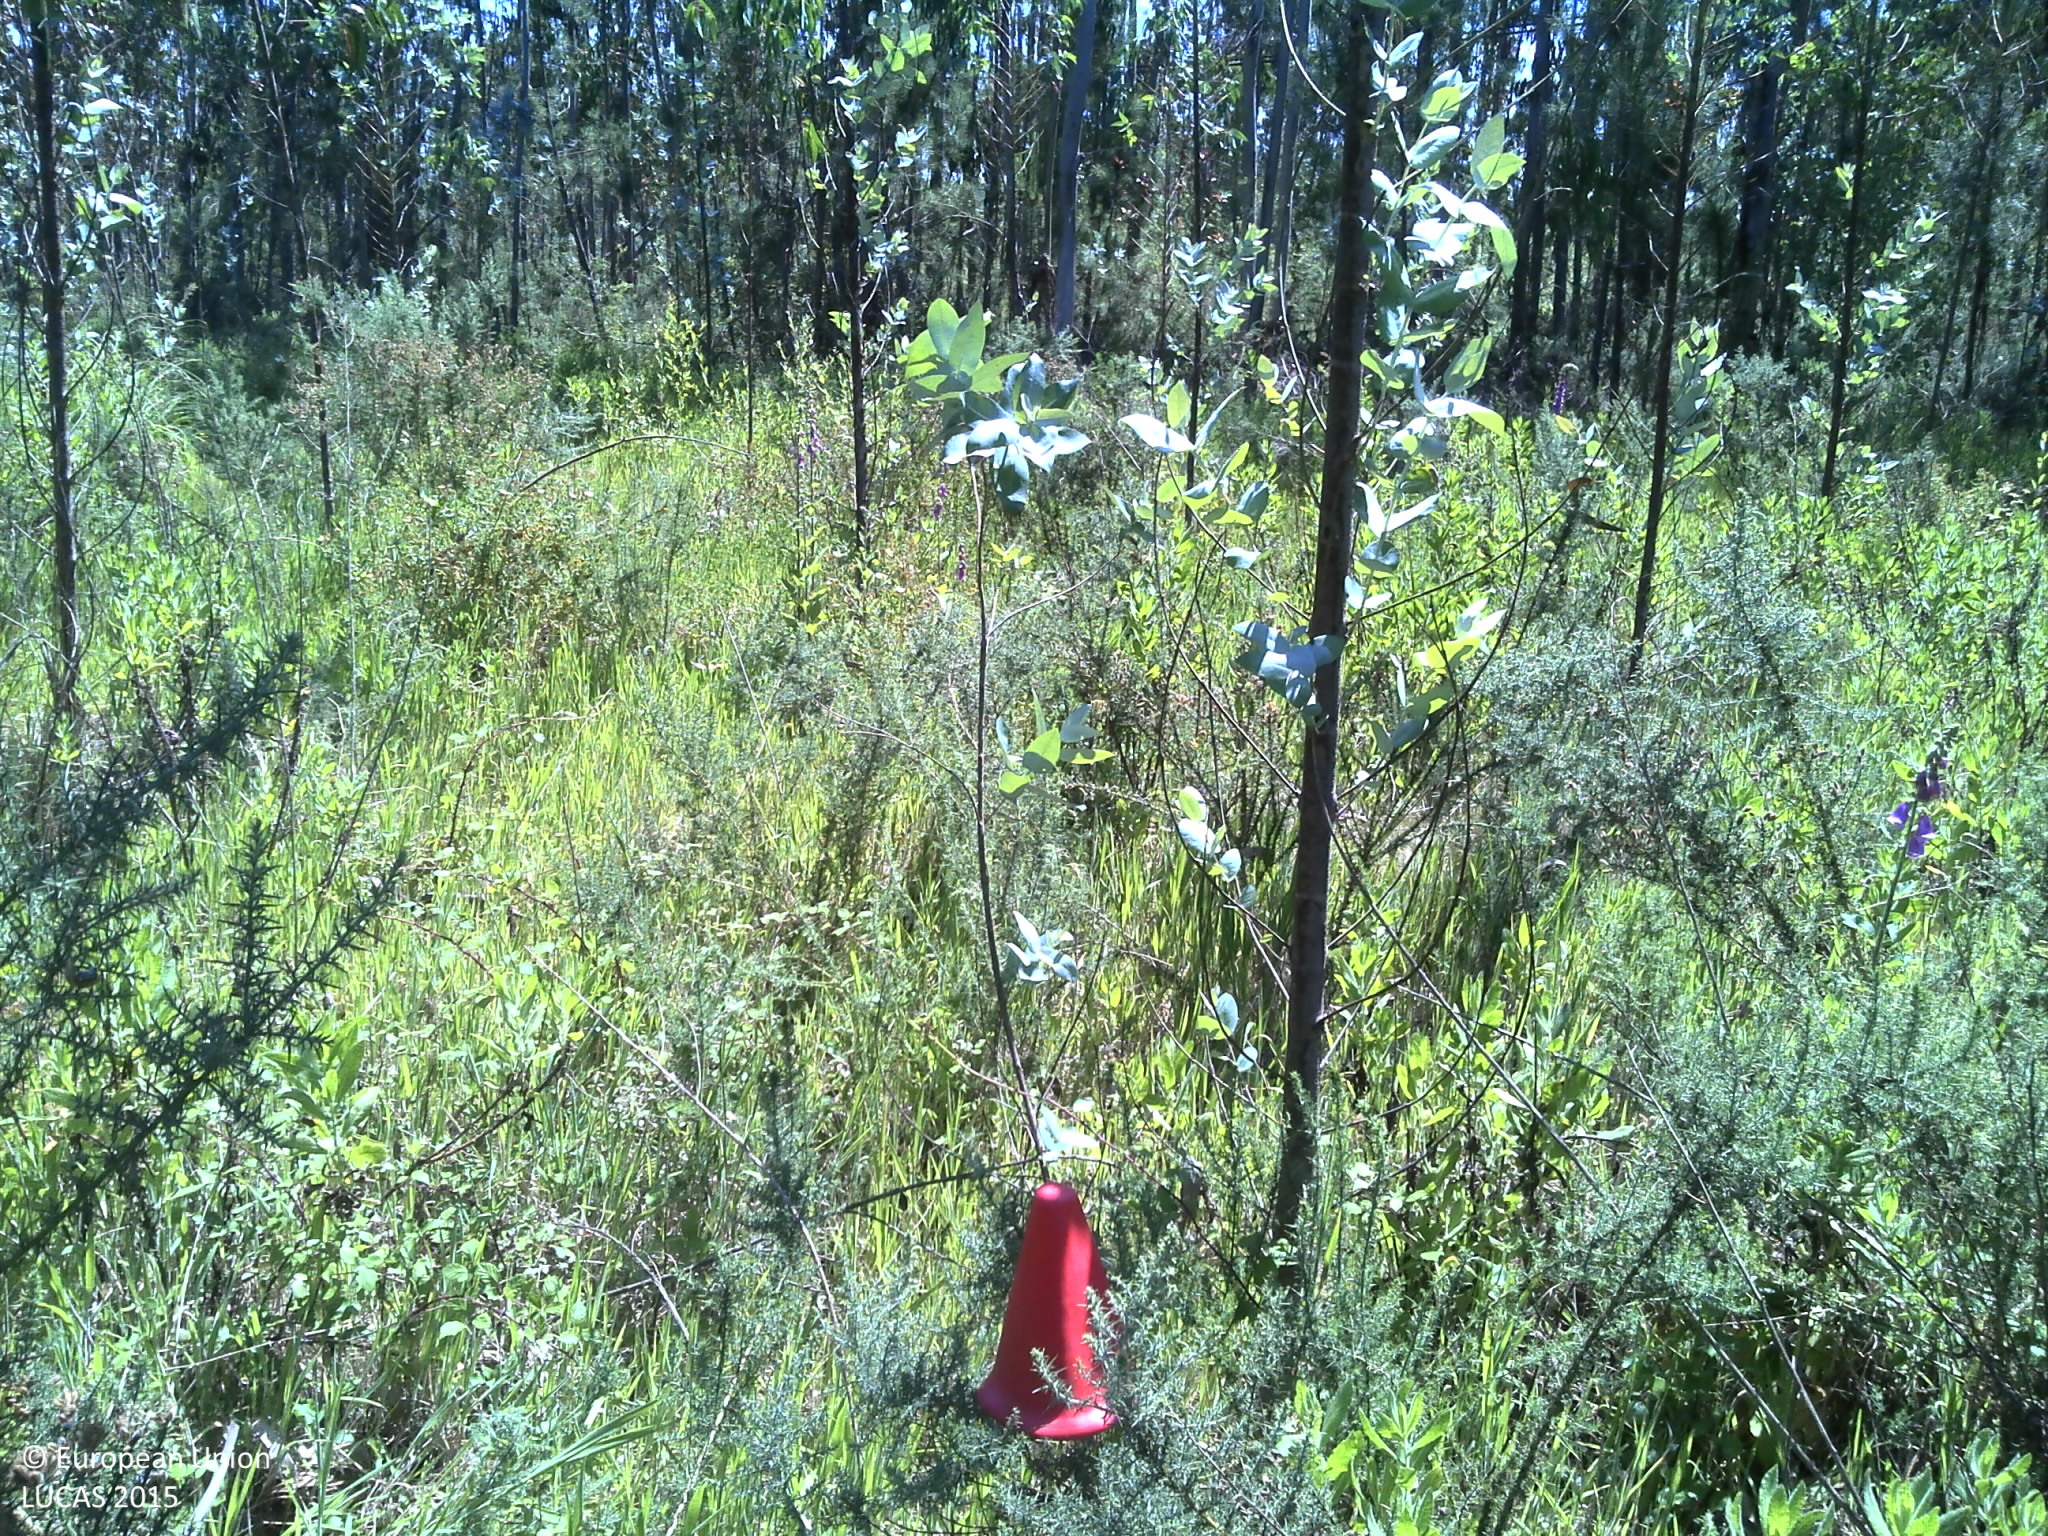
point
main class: Woodland
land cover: Broadleaved woodland
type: exotic forest
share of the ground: 25 - 50 %
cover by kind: broadleaved forest trees 50 %, shrubs 30 %, herbaceous plants 10 %, unconsolidated bare surface 10 %
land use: Forestry
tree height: < 5 m
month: May
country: PT
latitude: 40.4126
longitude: -8.6057
